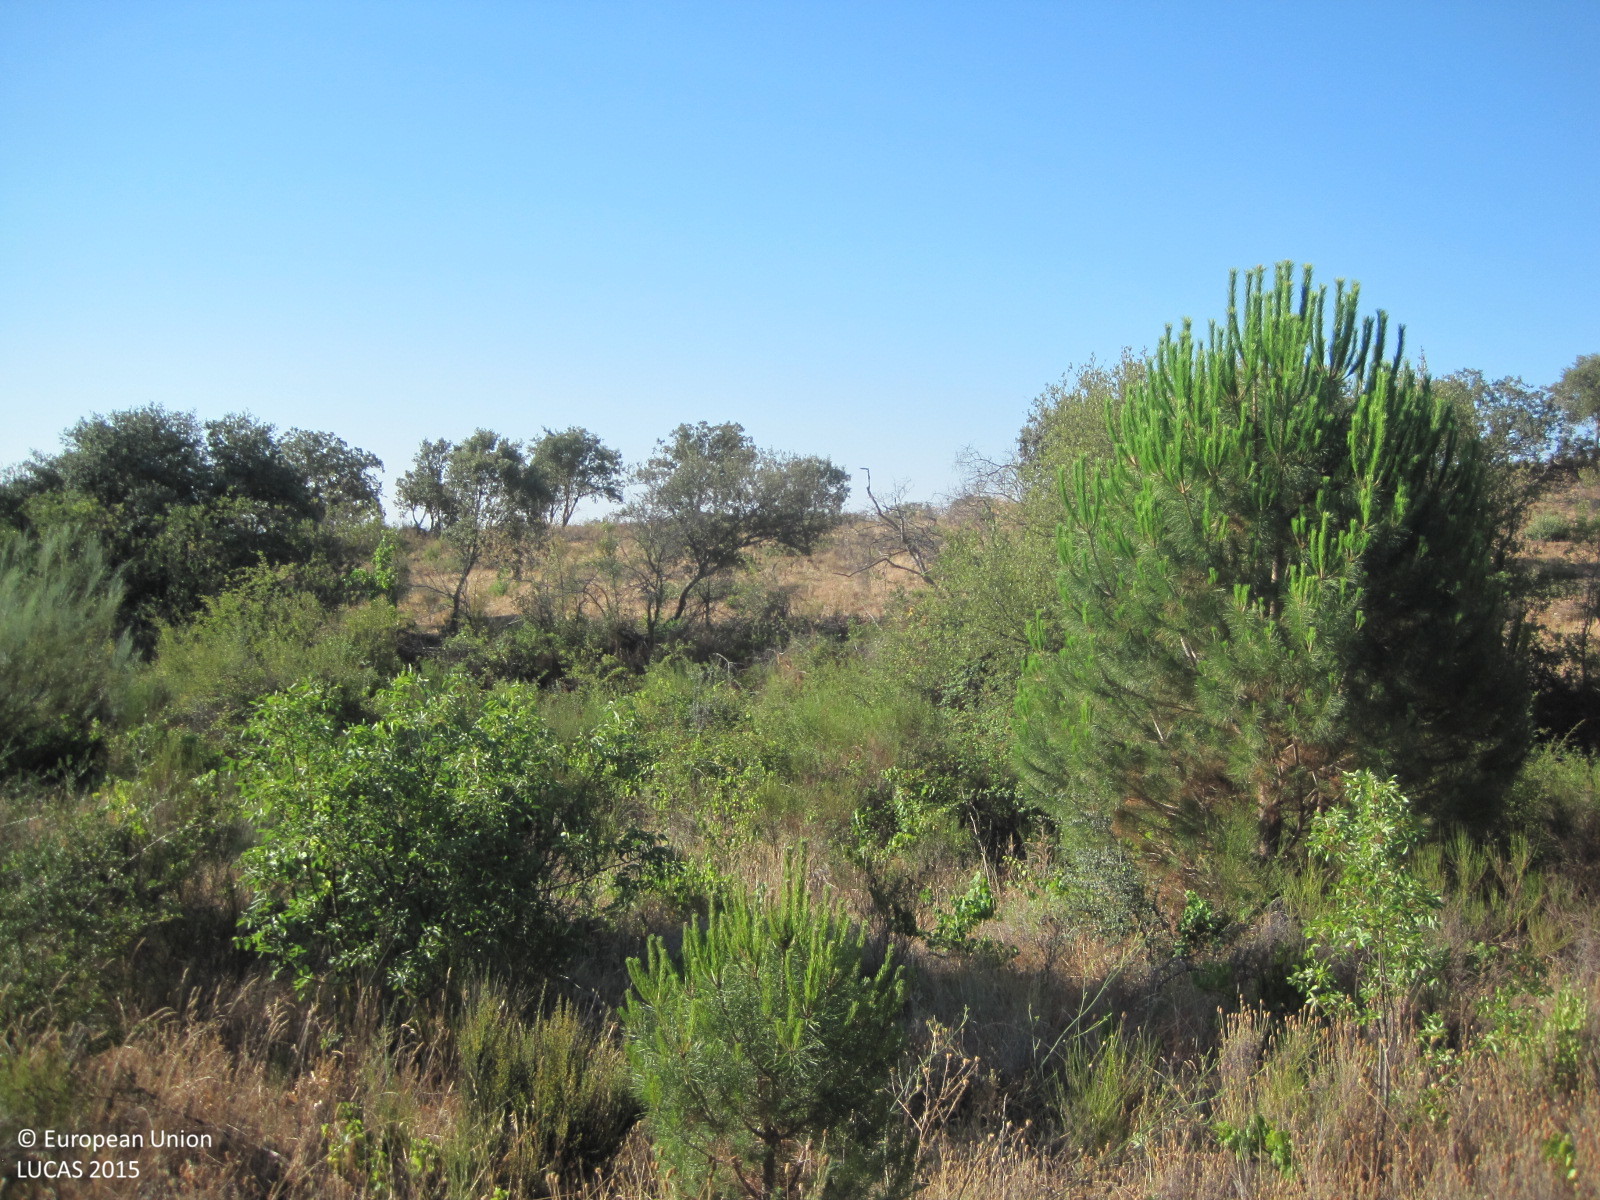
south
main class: Shrubland
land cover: Shrubland with sparse tree cover
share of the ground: > 75 %
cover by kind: shrubs 95 %, coniferous forest trees 5 %
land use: Semi-natural and natural areas not in use
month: July
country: ES
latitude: 40.2624
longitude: -4.4024
